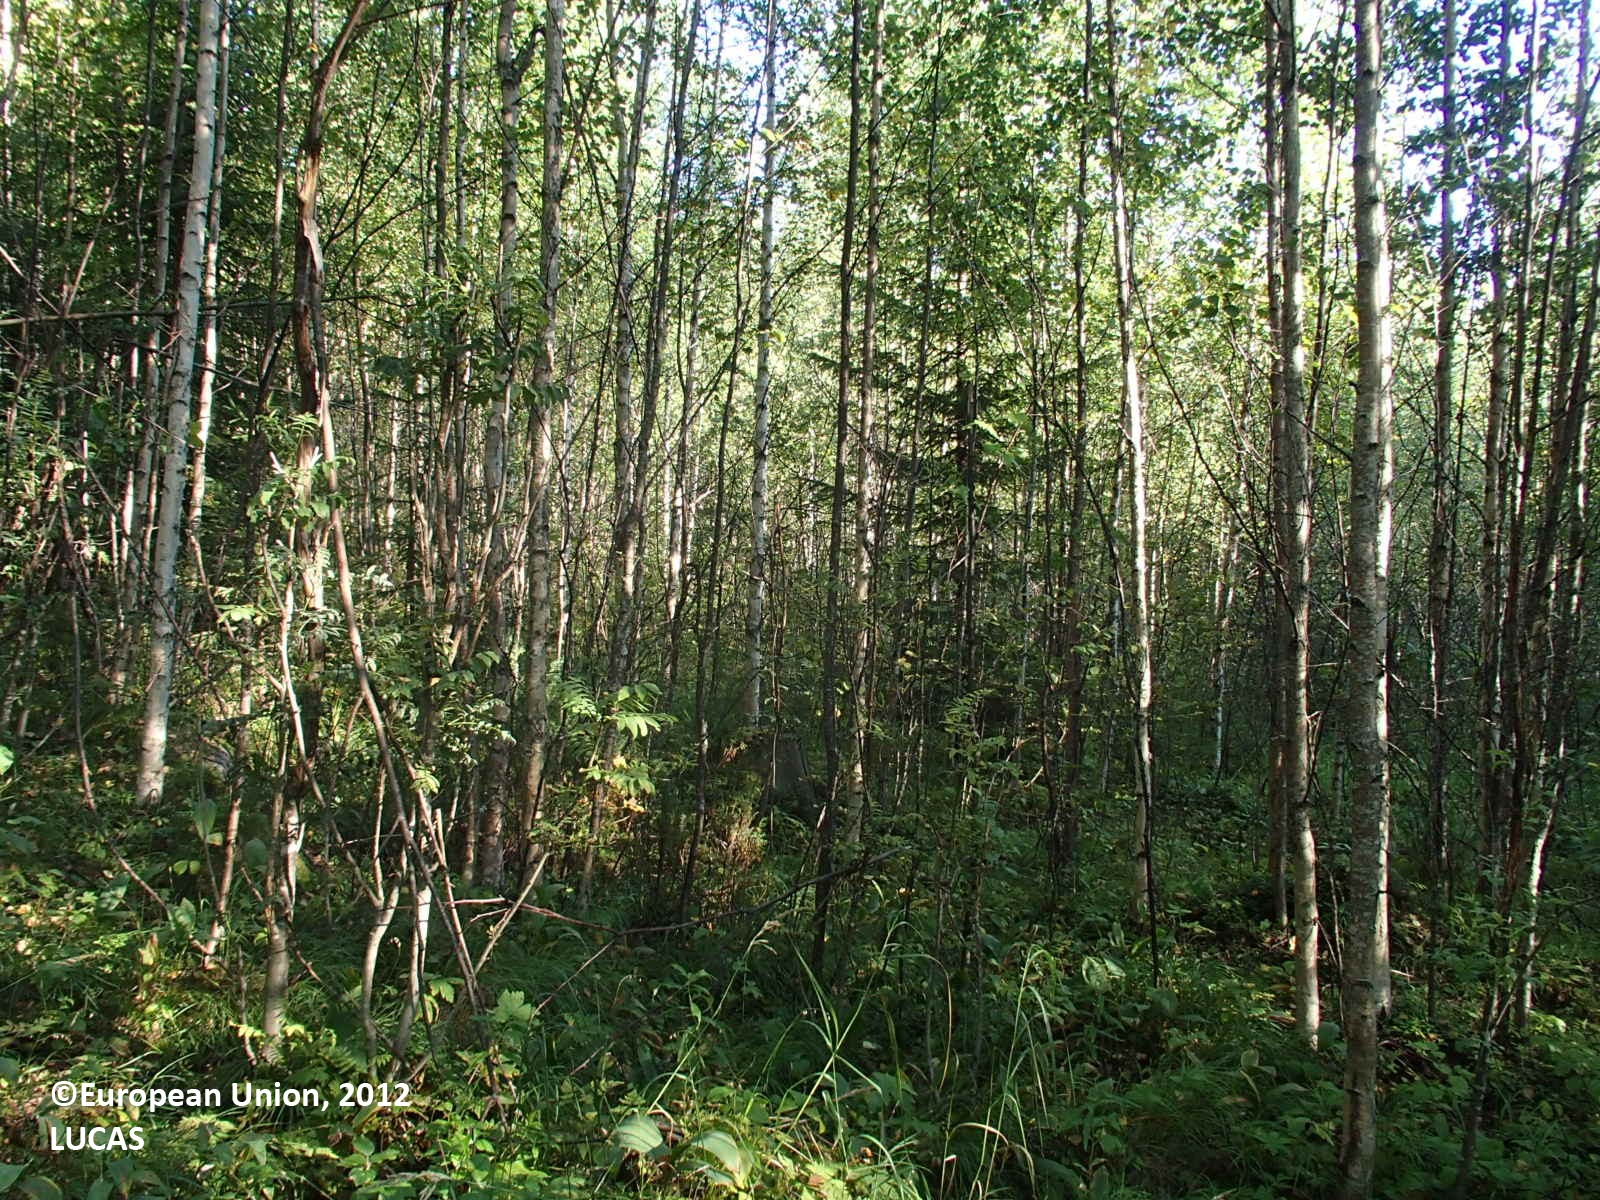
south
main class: Woodland
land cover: Broadleaved woodland
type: non-riverine alder, birch or aspen forest
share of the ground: > 75 %
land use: Forestry
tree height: > 5 m
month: August
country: FI
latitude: 63.5264
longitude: 27.9647
